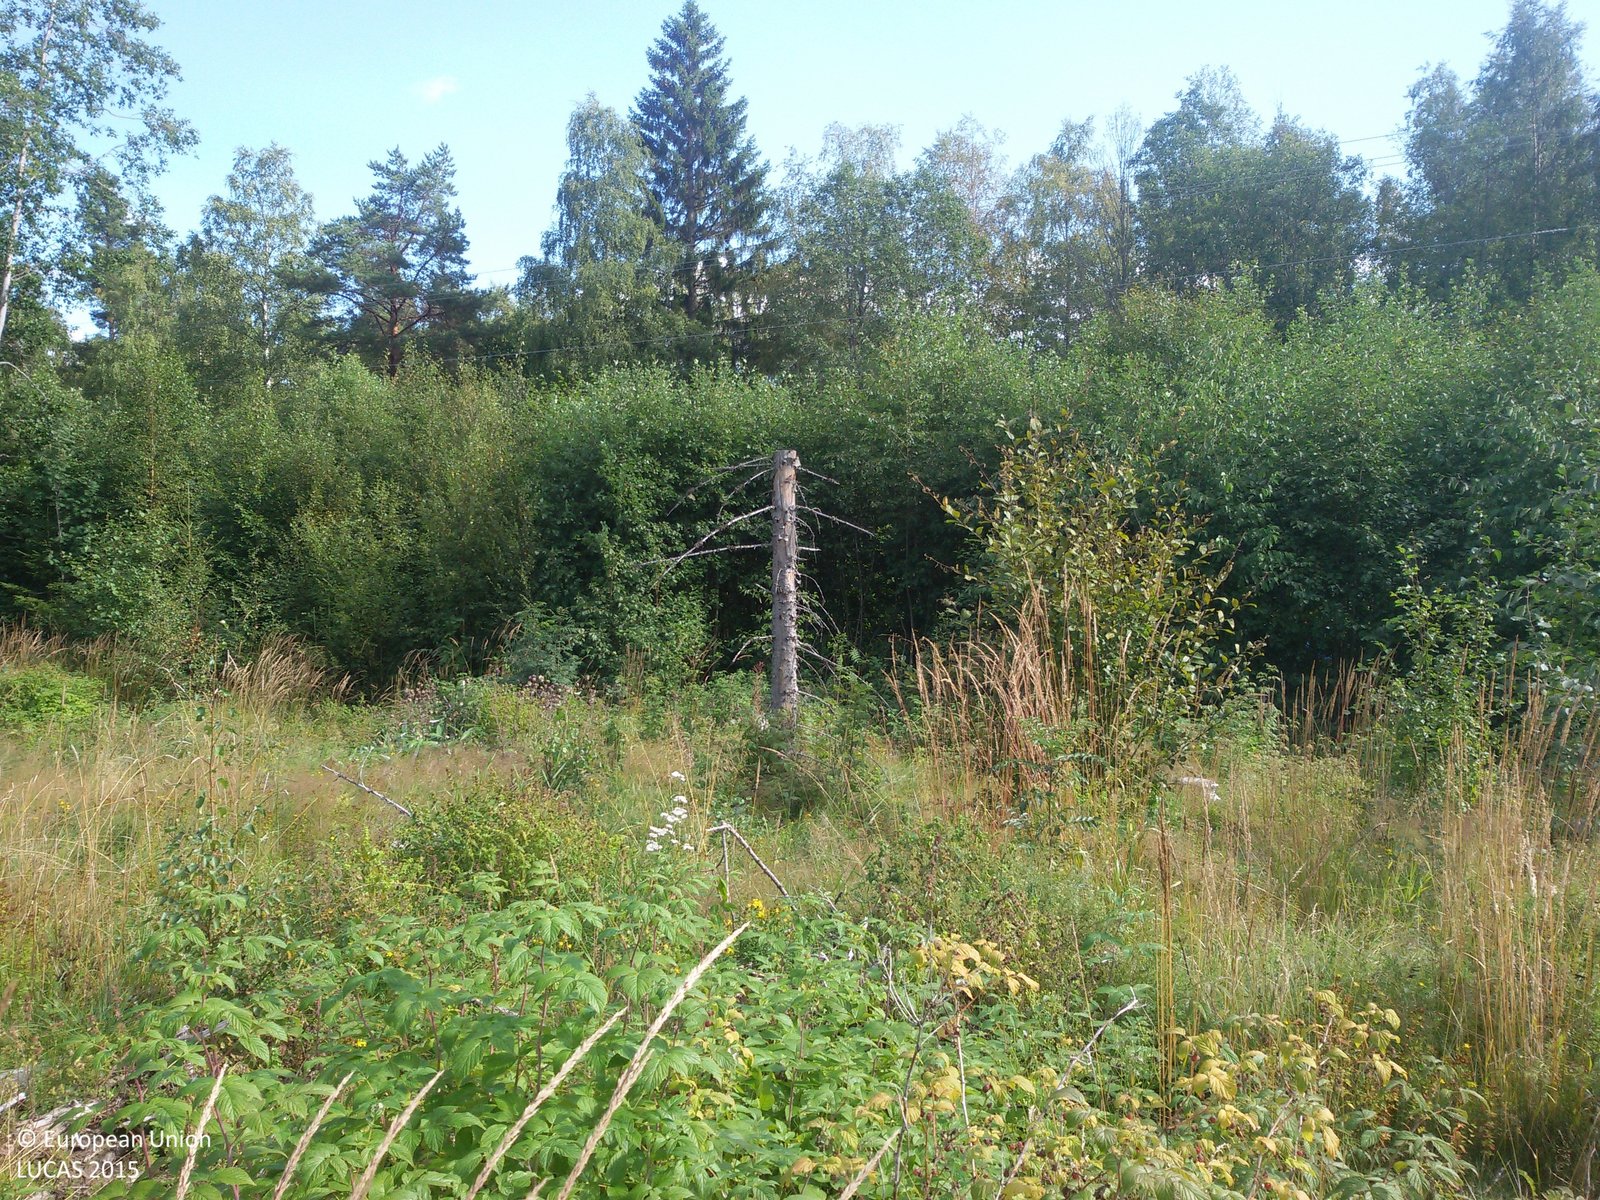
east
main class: Woodland
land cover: Broadleaved woodland
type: boreal forest
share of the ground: 10 - 25 %
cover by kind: herbaceous plants 60 %, shrubs 30 %, broadleaved forest trees 10 %
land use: Forestry
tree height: < 5 m
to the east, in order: Broadleaved woodland; Electric lines; Ditches and canals; Paved roads, cycling and walking lanes; Broadleaved woodland; Rivers and streams; Broadleaved woodland; Inland fresh water bodies
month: August
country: SE
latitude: 60.7923
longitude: 16.0309
